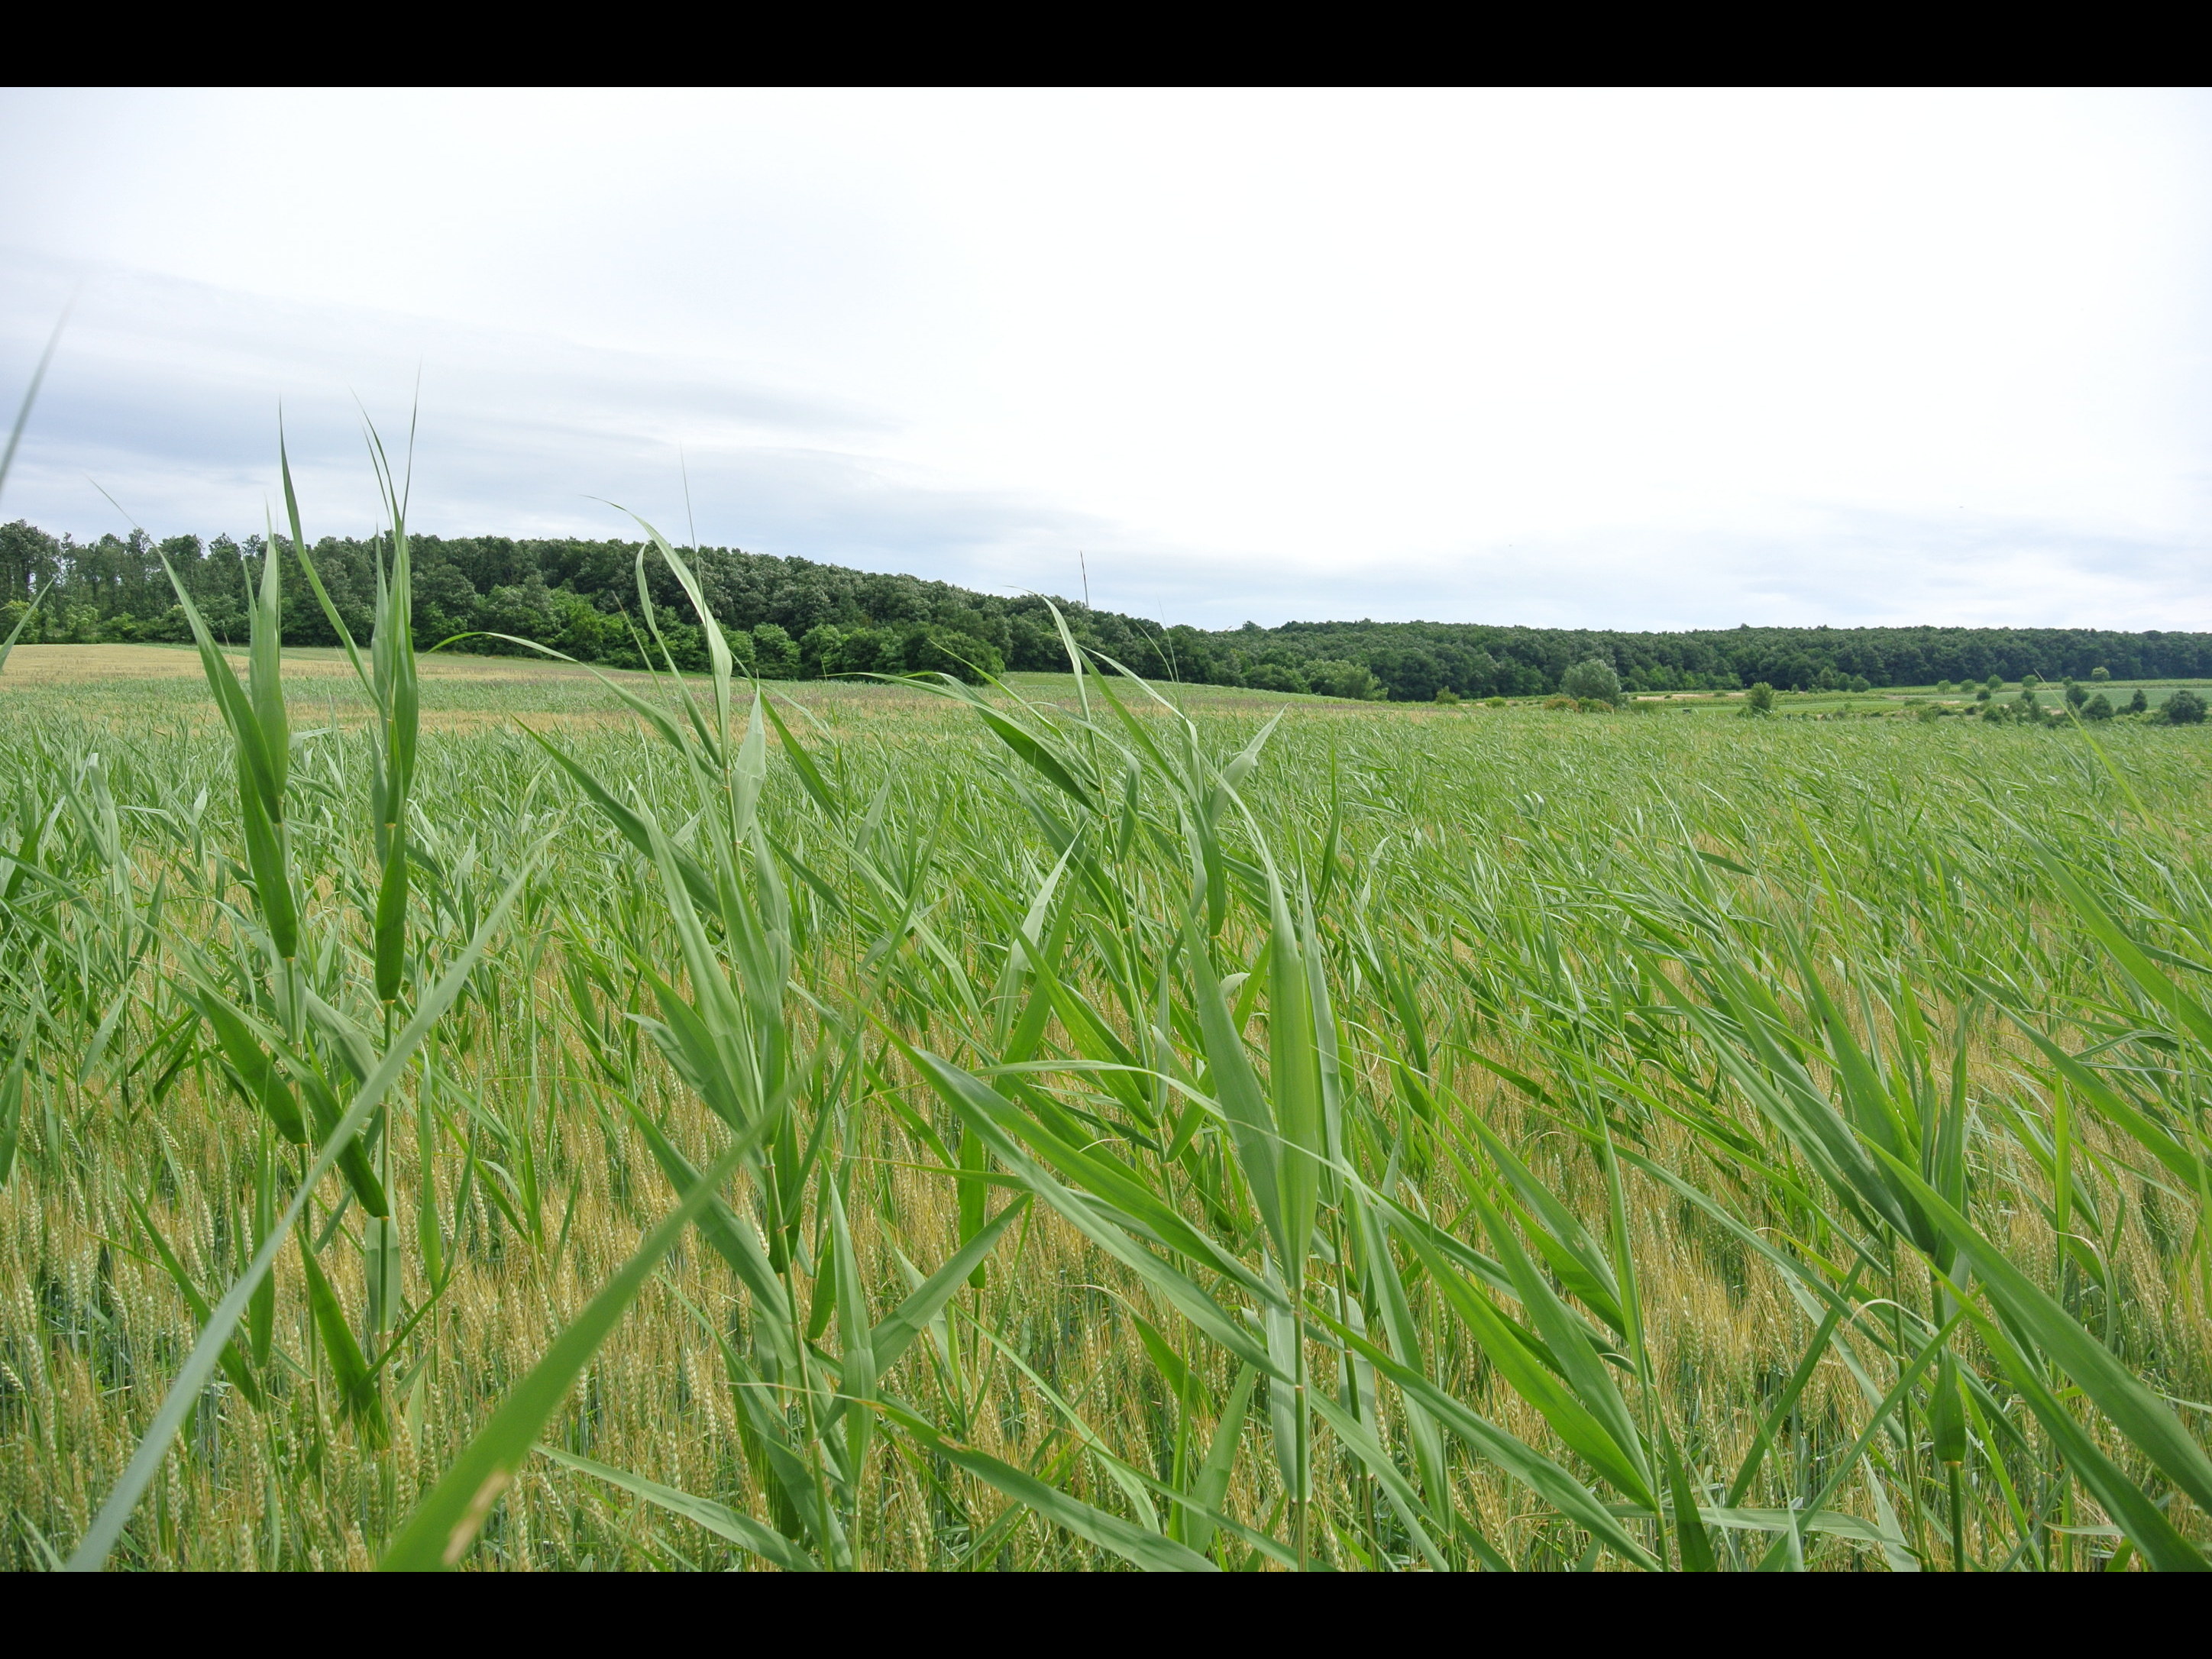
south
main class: Cropland
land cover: Common wheat
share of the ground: > 75 %
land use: Agriculture (excluding fallow land and kitchen gardens)
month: June
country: AT
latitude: 47.7592
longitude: 16.5282
